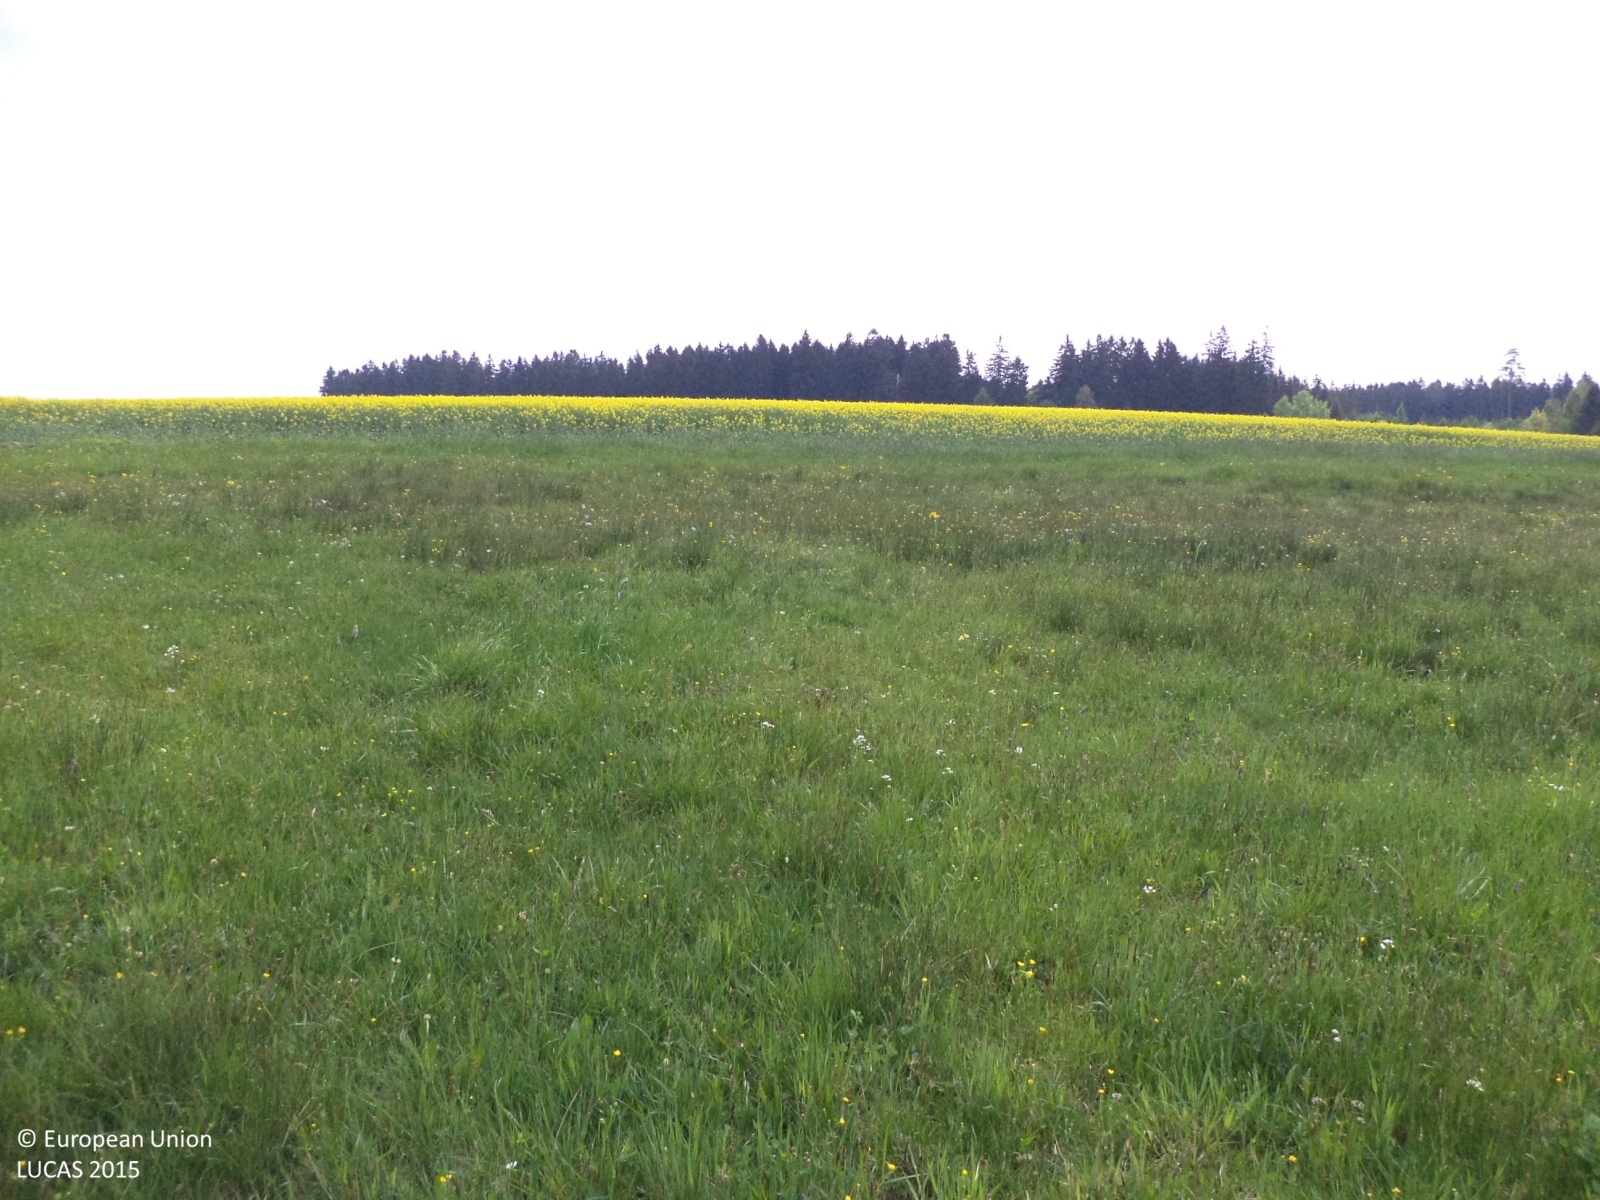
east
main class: Grassland
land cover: Grassland without tree/shrub cover
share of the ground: > 75 %
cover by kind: herbaceous plants 100 %
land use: Agriculture (excluding fallow land and kitchen gardens)
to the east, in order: Grassland without tree/shrub cover; Rape and turnip rape
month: May
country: CZ
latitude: 49.3681
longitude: 15.0840
